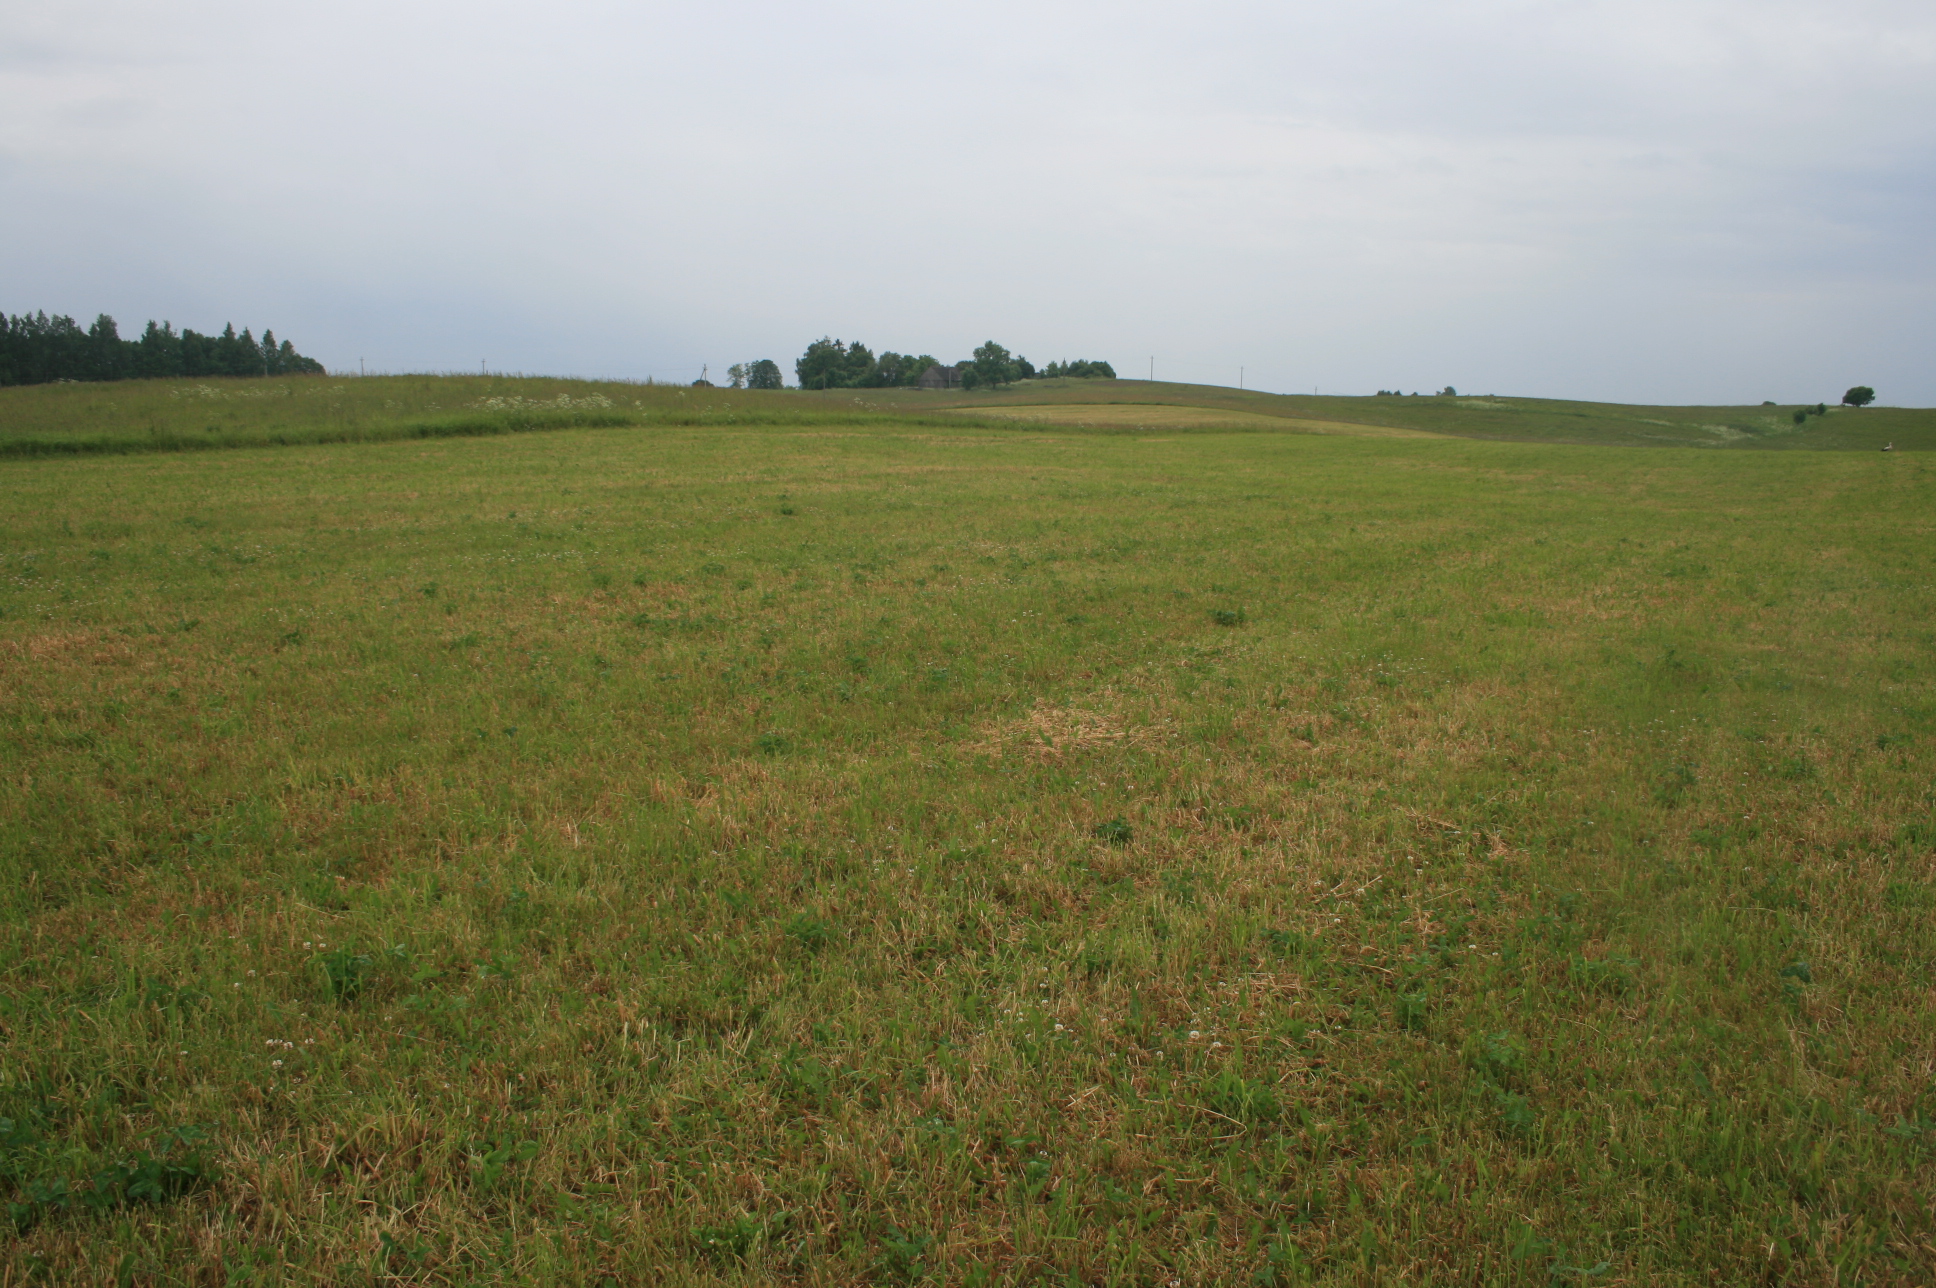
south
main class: Grassland
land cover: Grassland without tree/shrub cover
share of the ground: > 75 %
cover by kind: herbaceous plants 100 %
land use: Agriculture (excluding fallow land and kitchen gardens)
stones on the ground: < 10 %
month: June
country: LT
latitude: 55.4965
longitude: 22.3580
